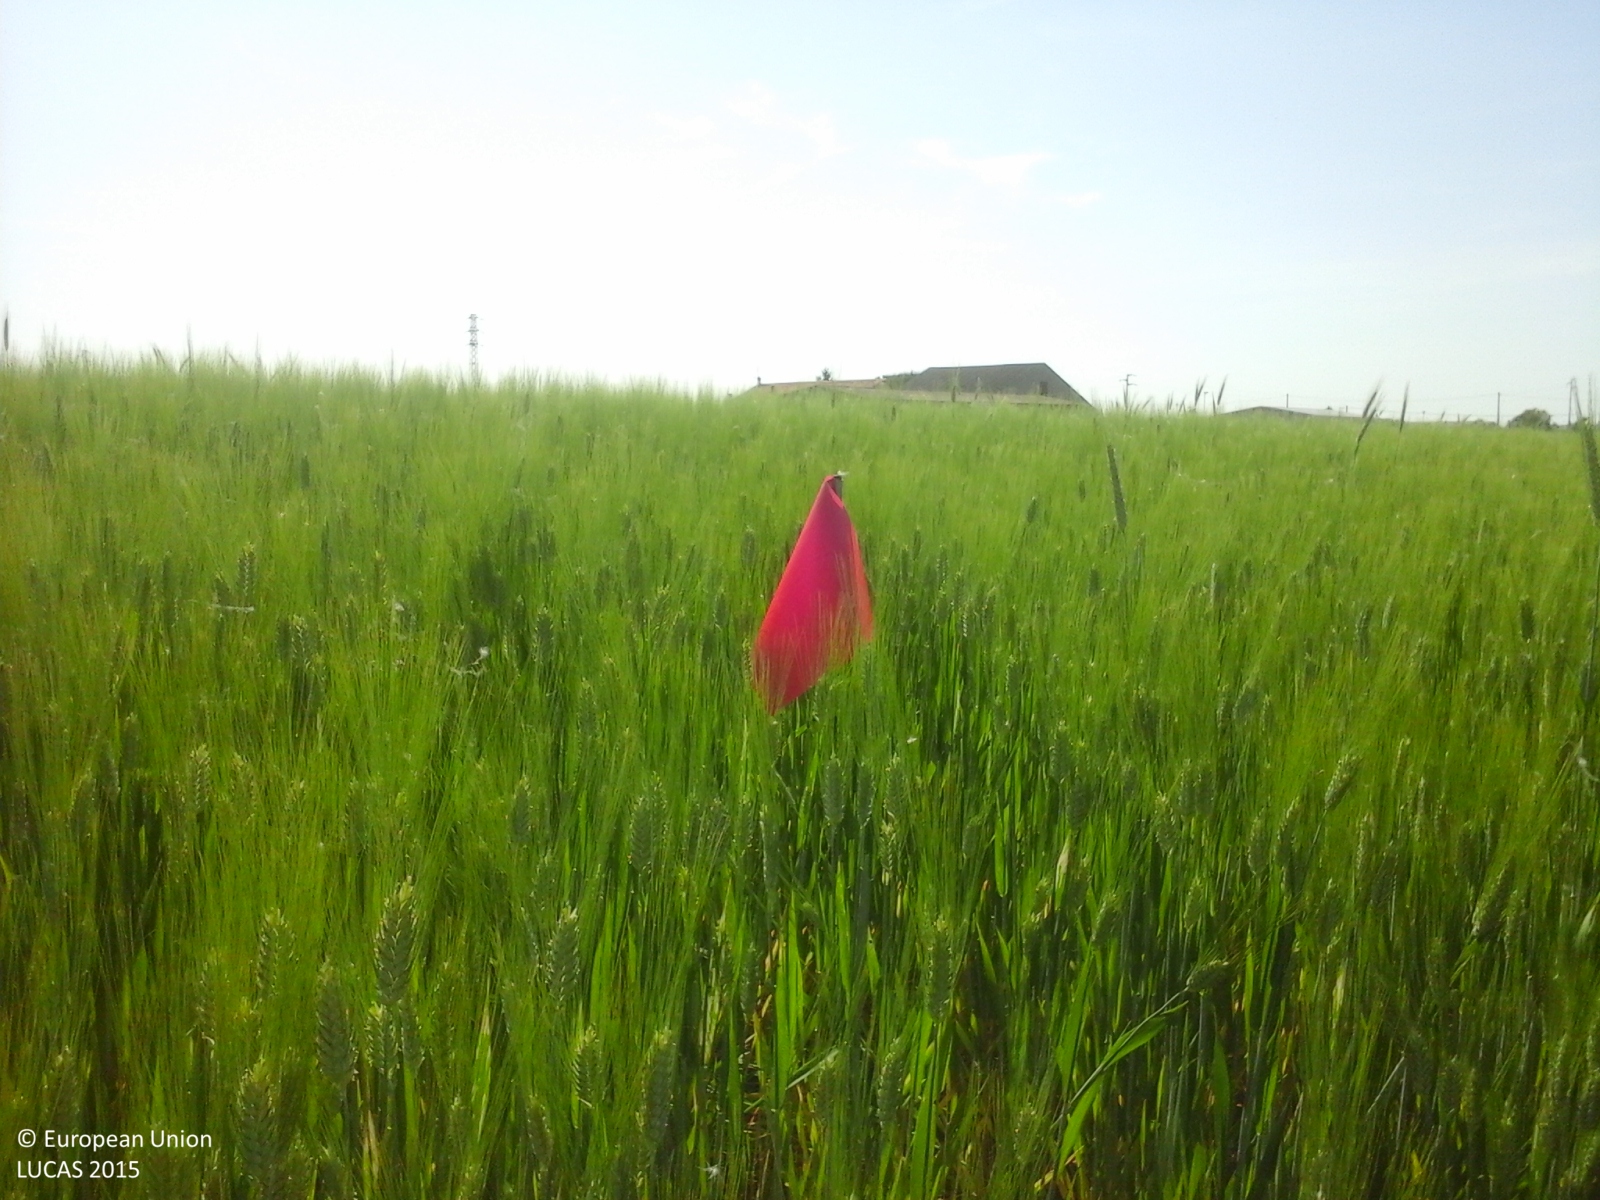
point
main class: Cropland
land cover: Common wheat
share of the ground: > 75 %
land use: Agriculture (excluding fallow land and kitchen gardens)
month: May
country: IT
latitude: 44.9673
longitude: 11.7337
